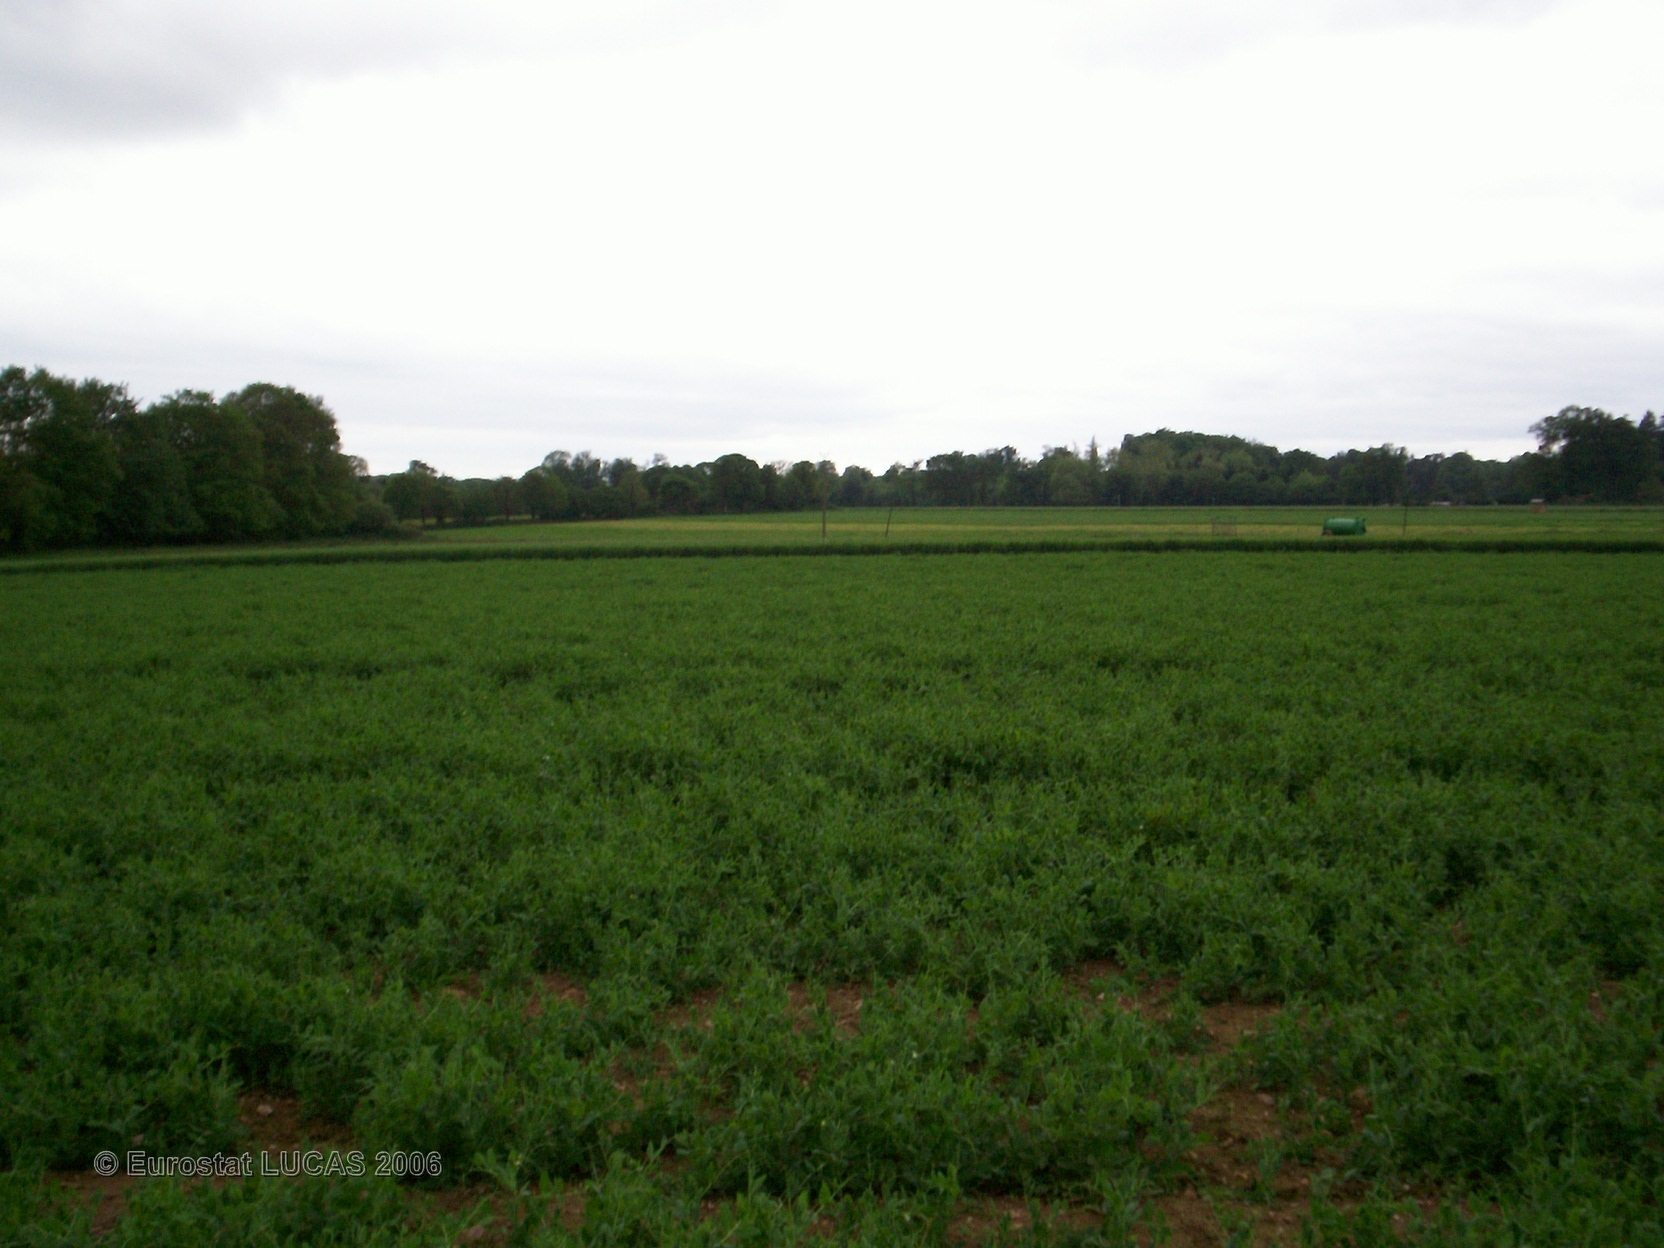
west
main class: Cropland
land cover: Dry pulses
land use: Agriculture (excluding fallow land and kitchen gardens)
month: May
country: FR
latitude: 48.1295
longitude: -2.3247
